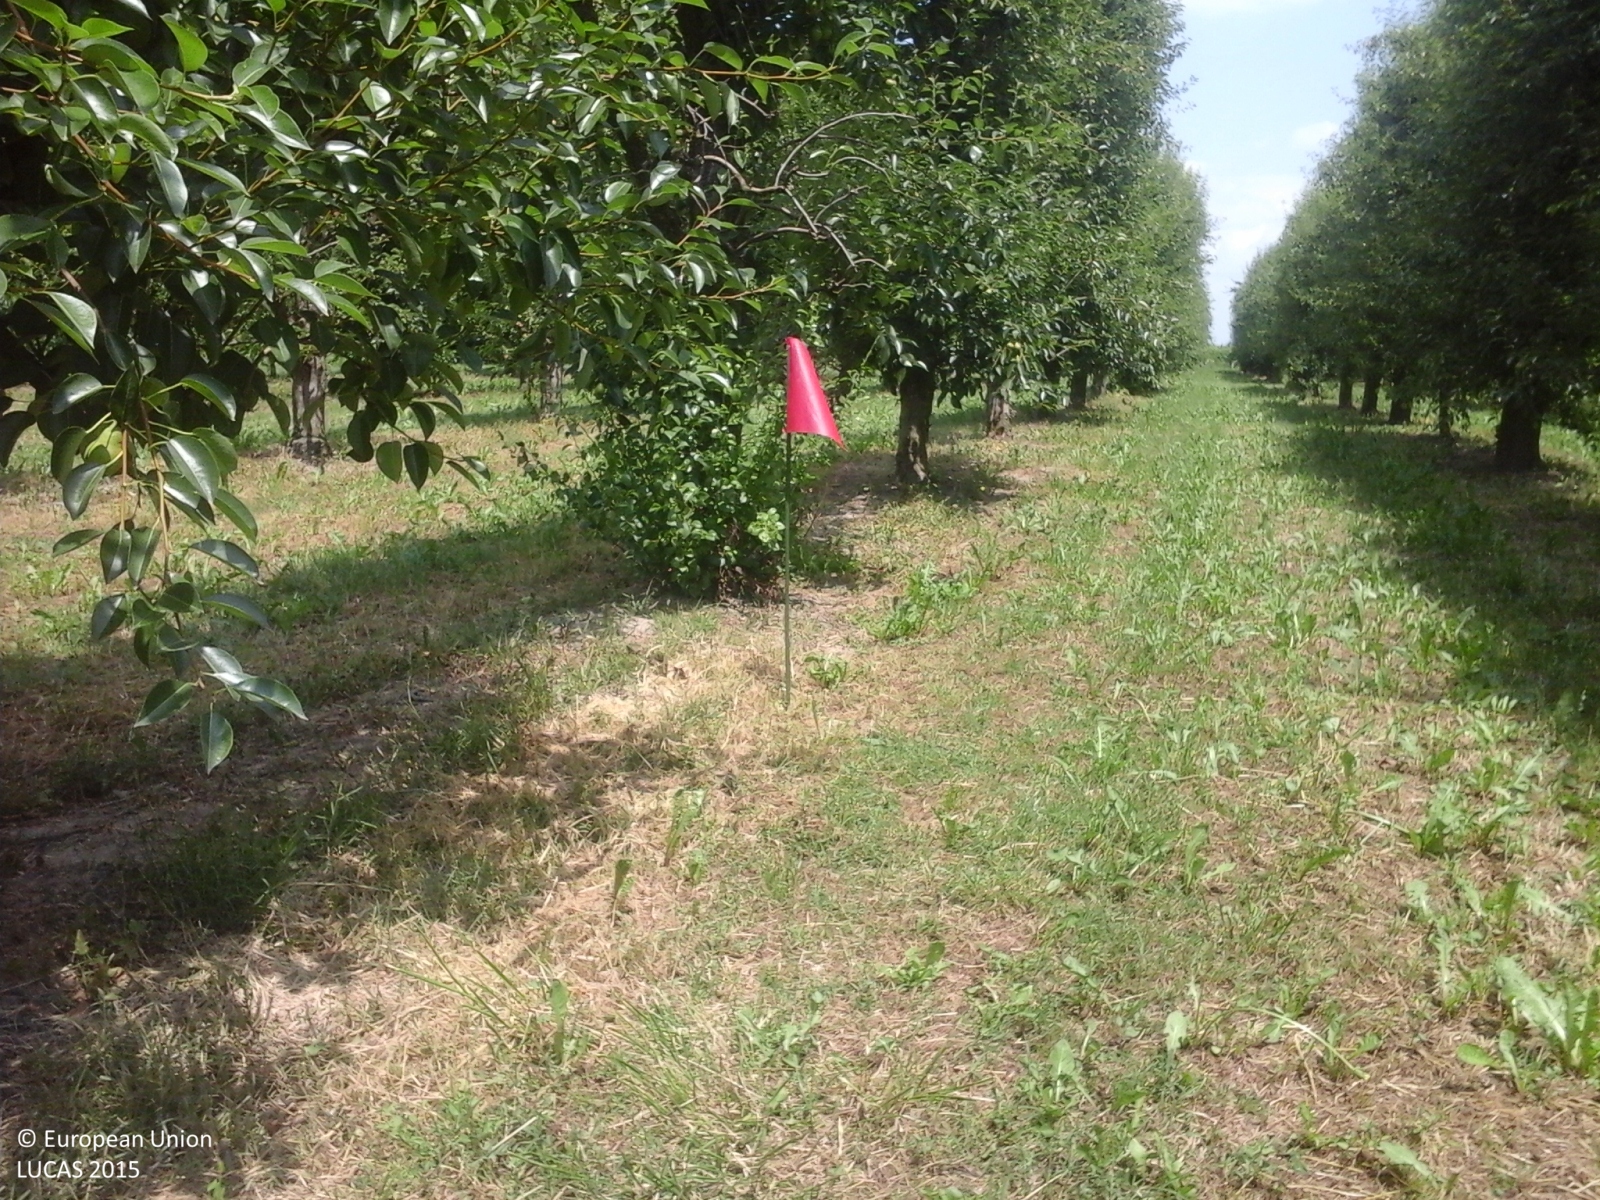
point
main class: Cropland
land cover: Pear fruit
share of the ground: > 75 %
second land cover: Grassland without tree/shrub cover
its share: > 75 %
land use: Agriculture (excluding fallow land and kitchen gardens)
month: June
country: IT
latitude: 44.7969
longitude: 10.9714
